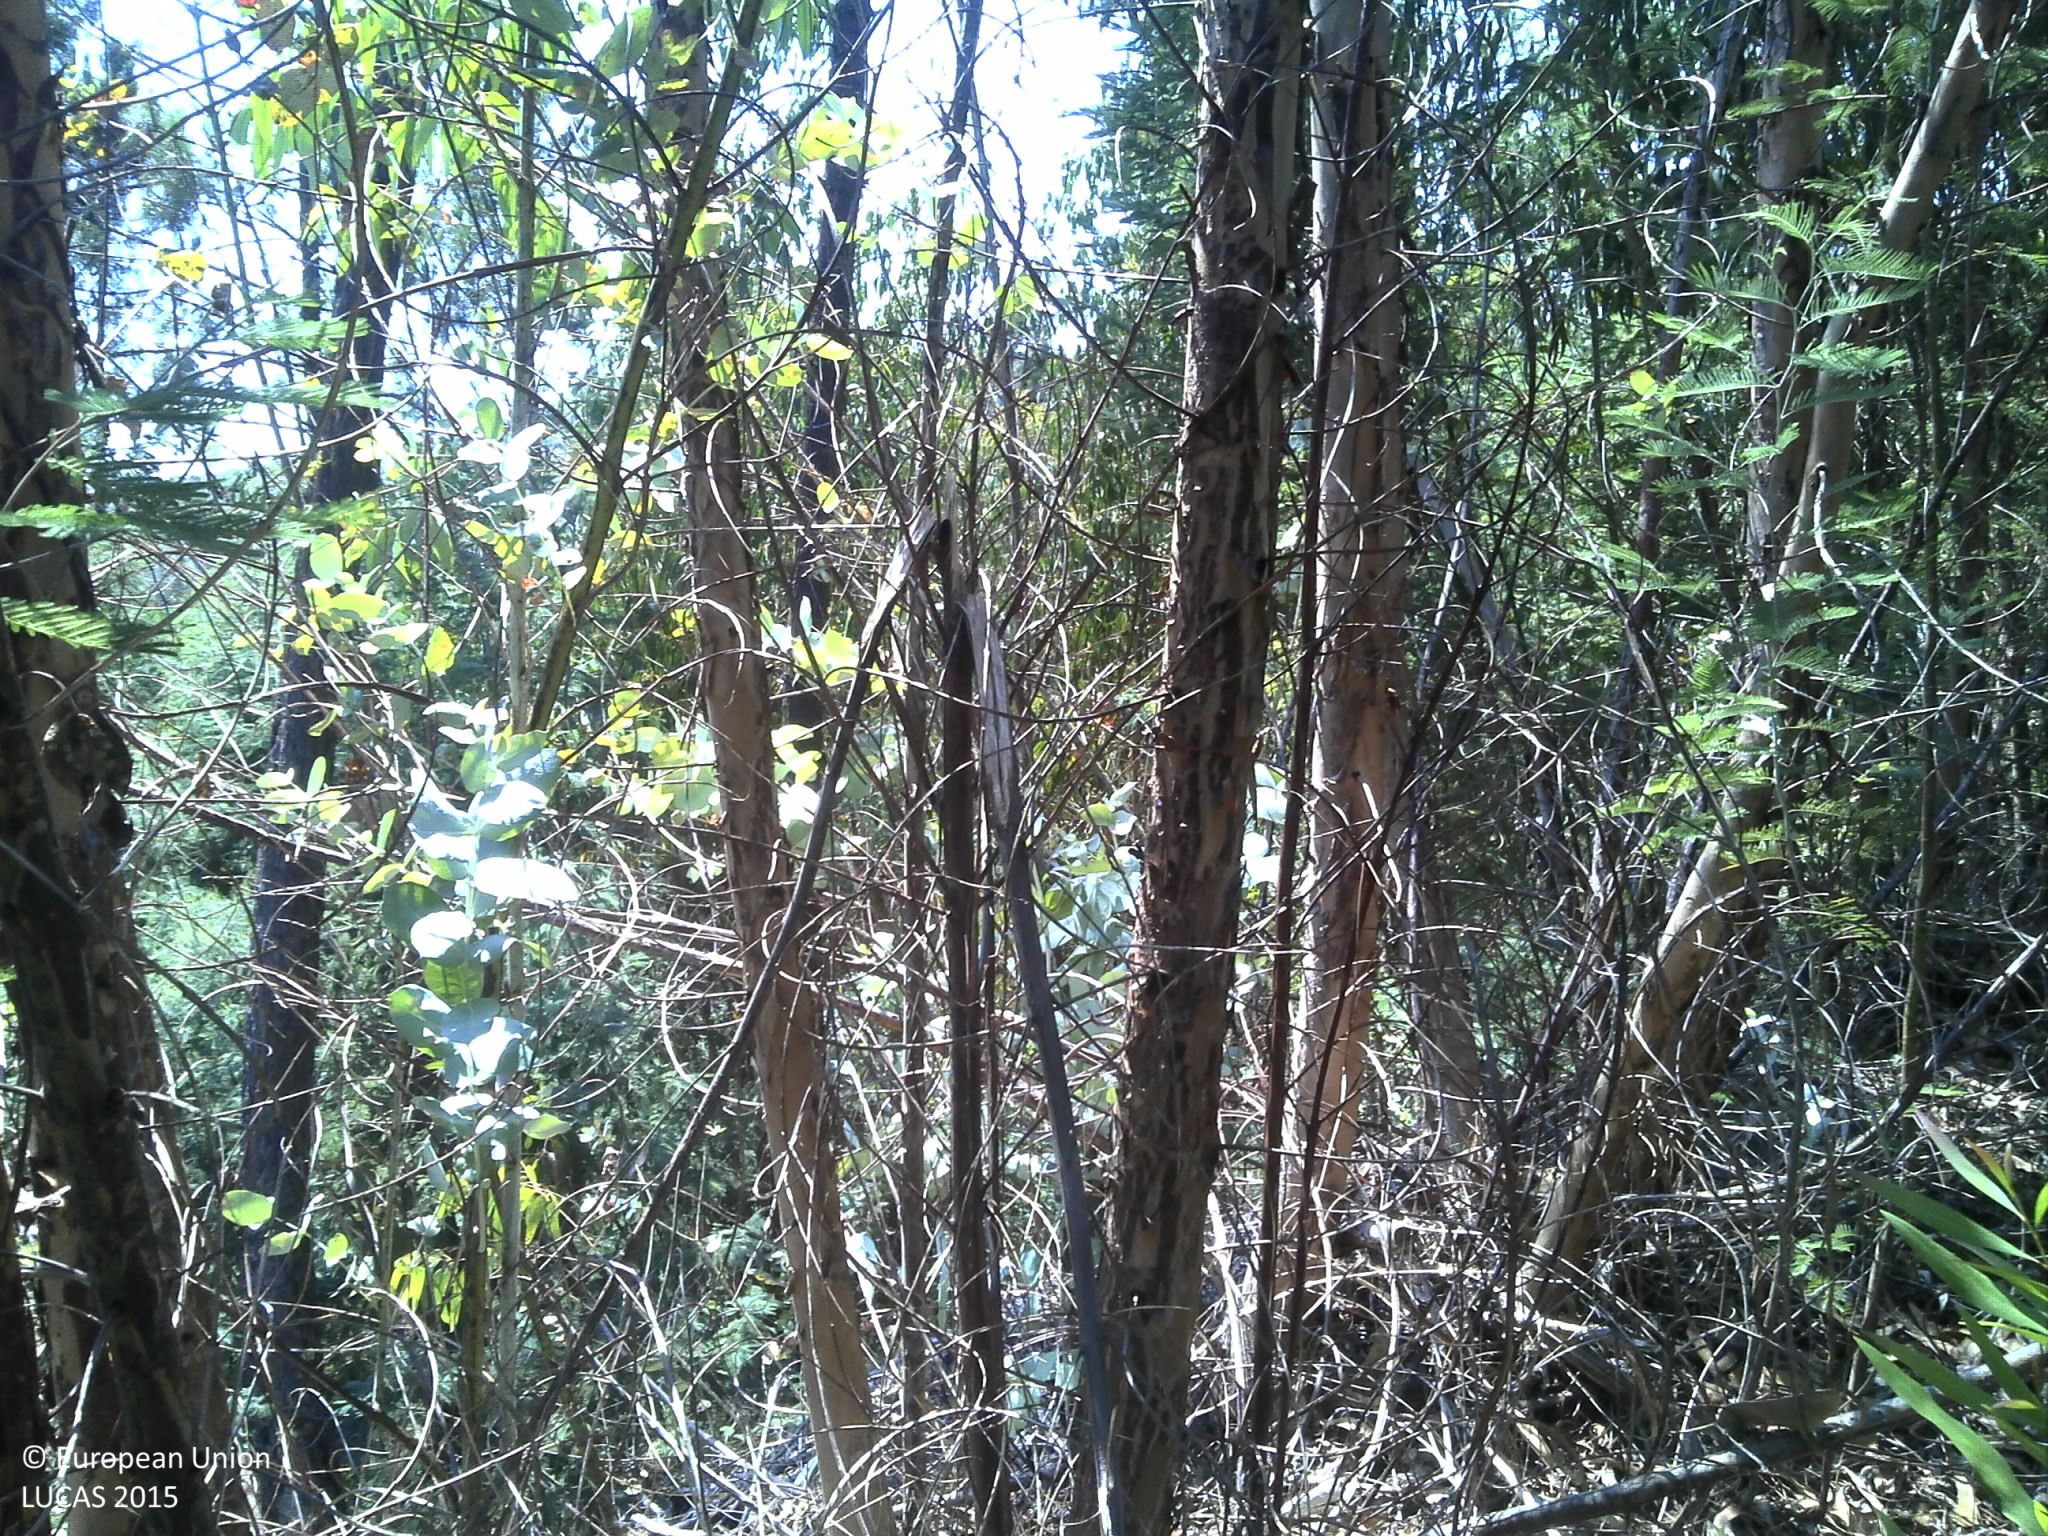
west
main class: Woodland
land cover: Broadleaved woodland
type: exotic forest
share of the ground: > 75 %
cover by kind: broadleaved forest trees 70 %, shrubs 20 %, unconsolidated bare surface 10 %
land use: Forestry
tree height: > 5 m
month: July
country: PT
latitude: 40.6970
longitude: -8.3747
